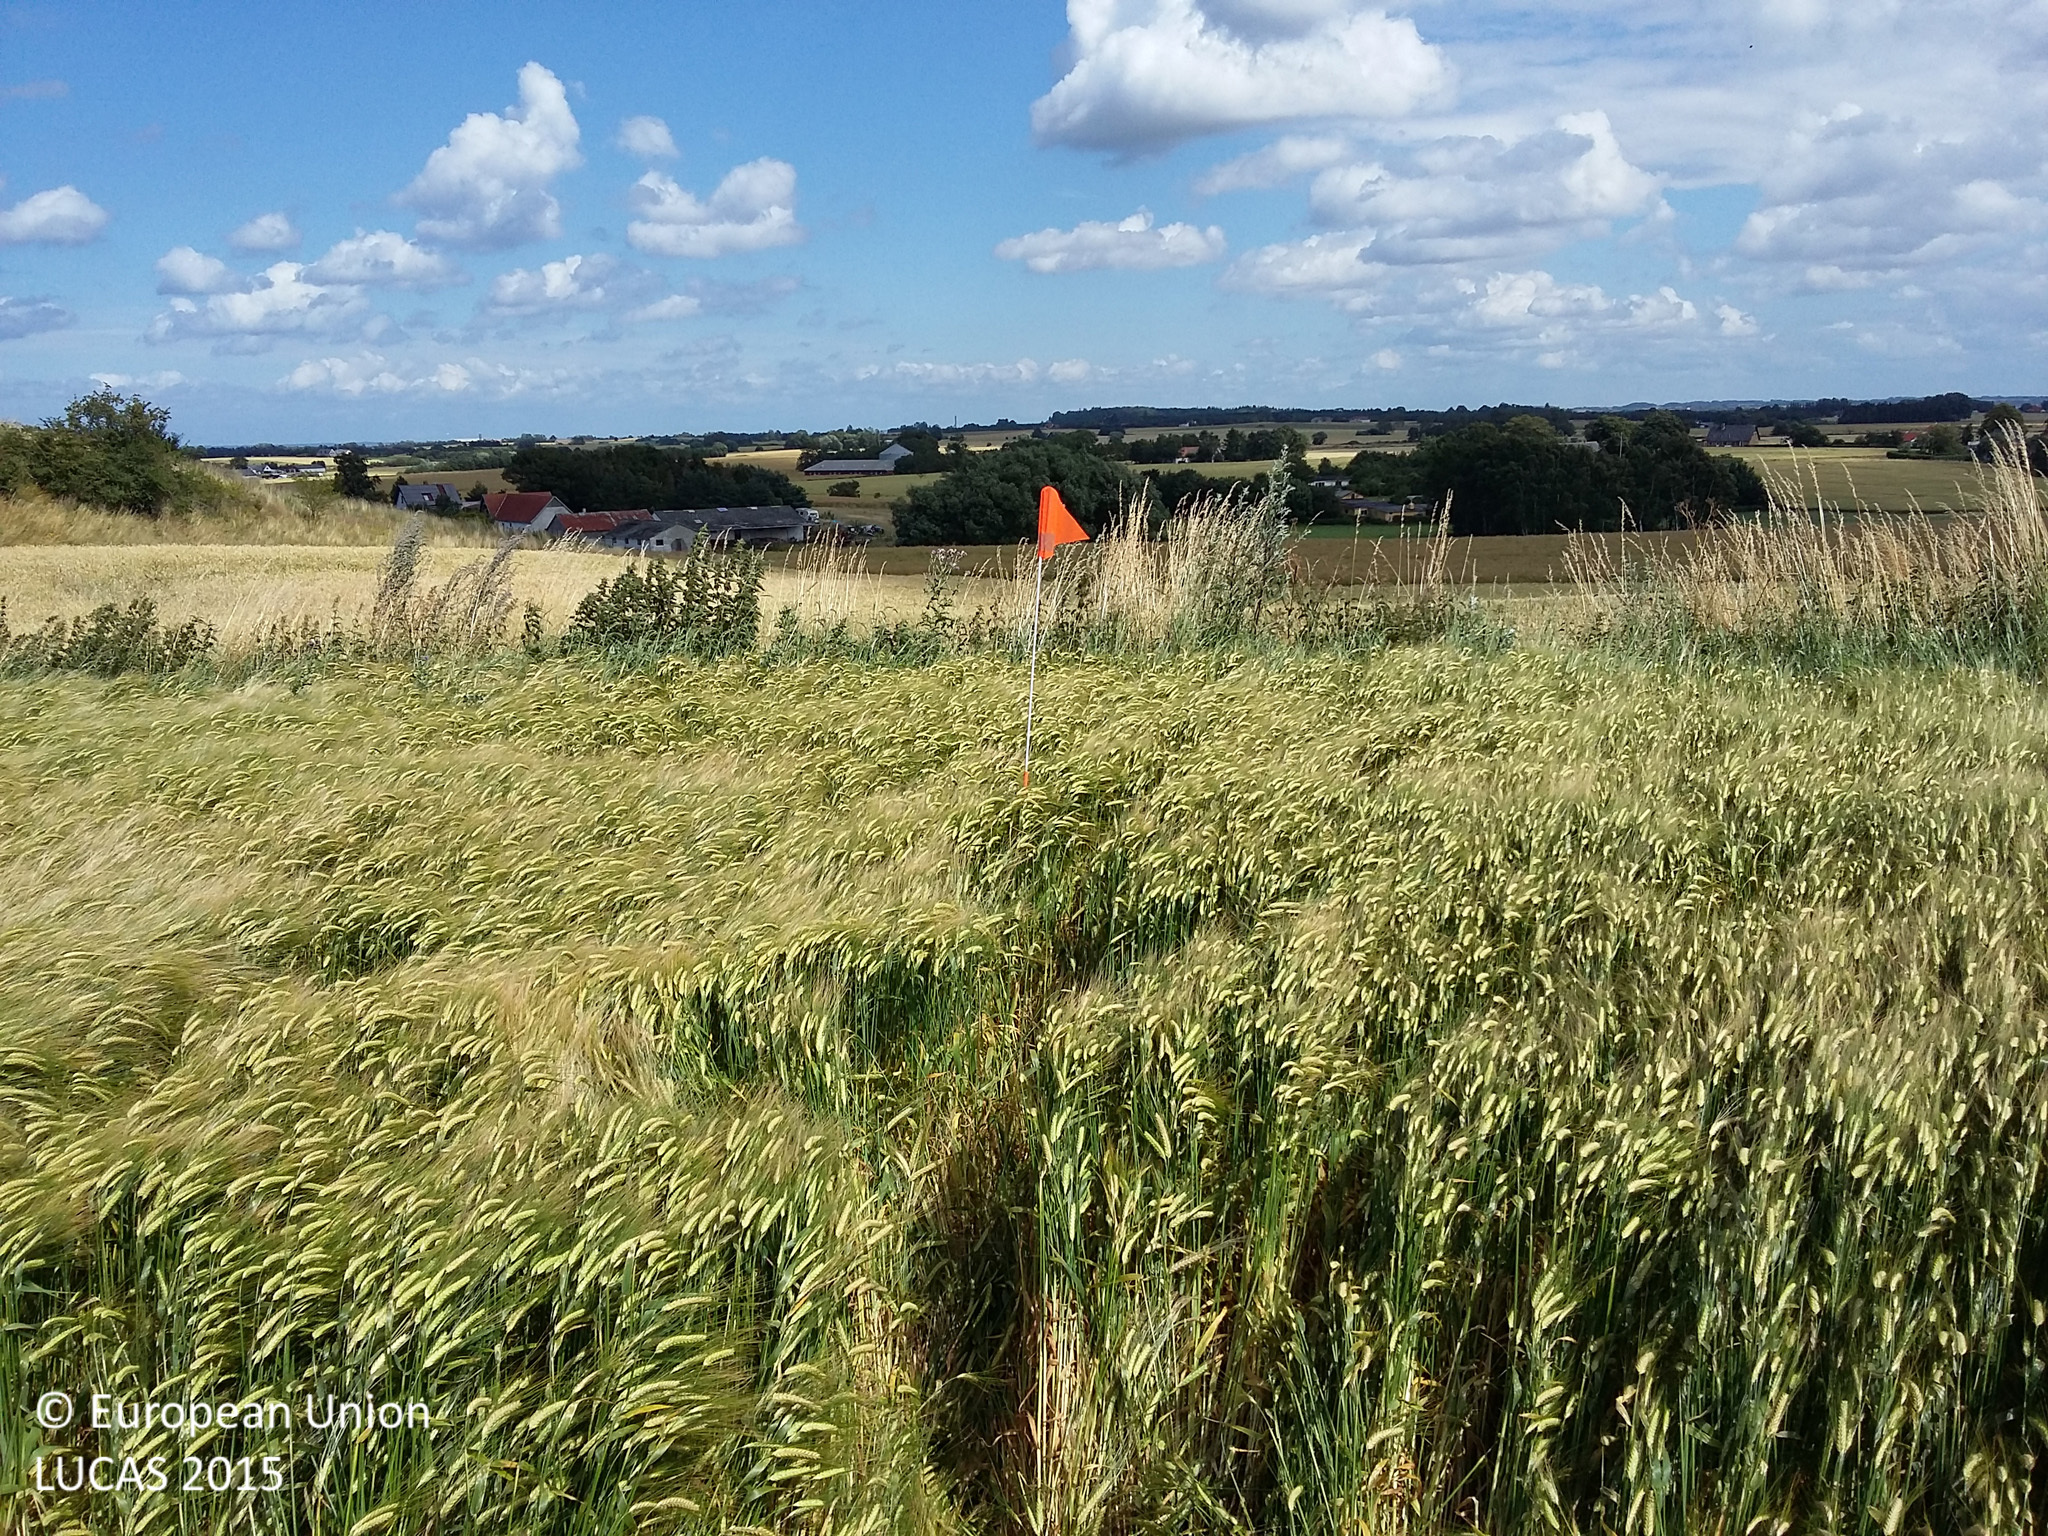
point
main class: Cropland
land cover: Barley
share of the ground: > 75 %
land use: Agriculture (excluding fallow land and kitchen gardens)
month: July
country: DK
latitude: 55.7634
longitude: 11.6718
